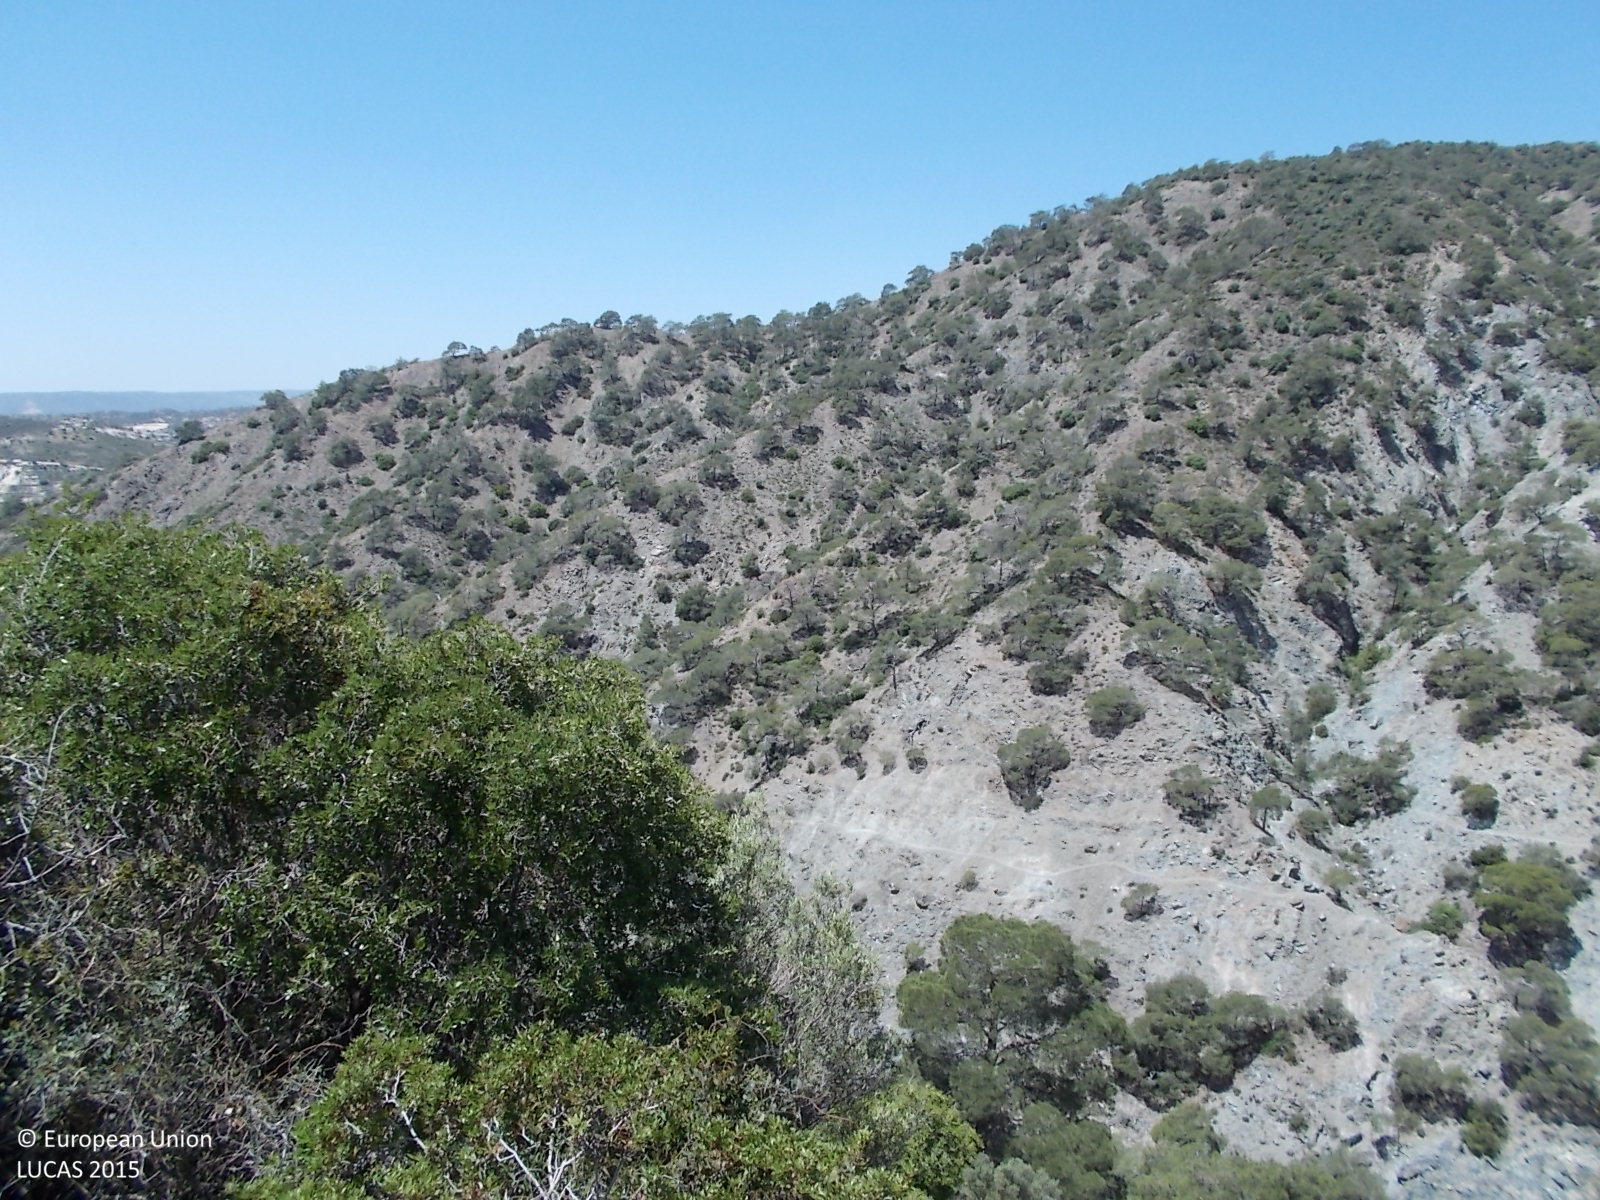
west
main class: Woodland
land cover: Pine dominated coniferous woodland
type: coniferous forest of the mediterranean region
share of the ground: 25 - 50 %
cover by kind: unconsolidated bare surface 55 %, coniferous forest trees 45 %
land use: Forestry
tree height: > 5 m
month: May
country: CY
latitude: 34.8063
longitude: 33.0252
